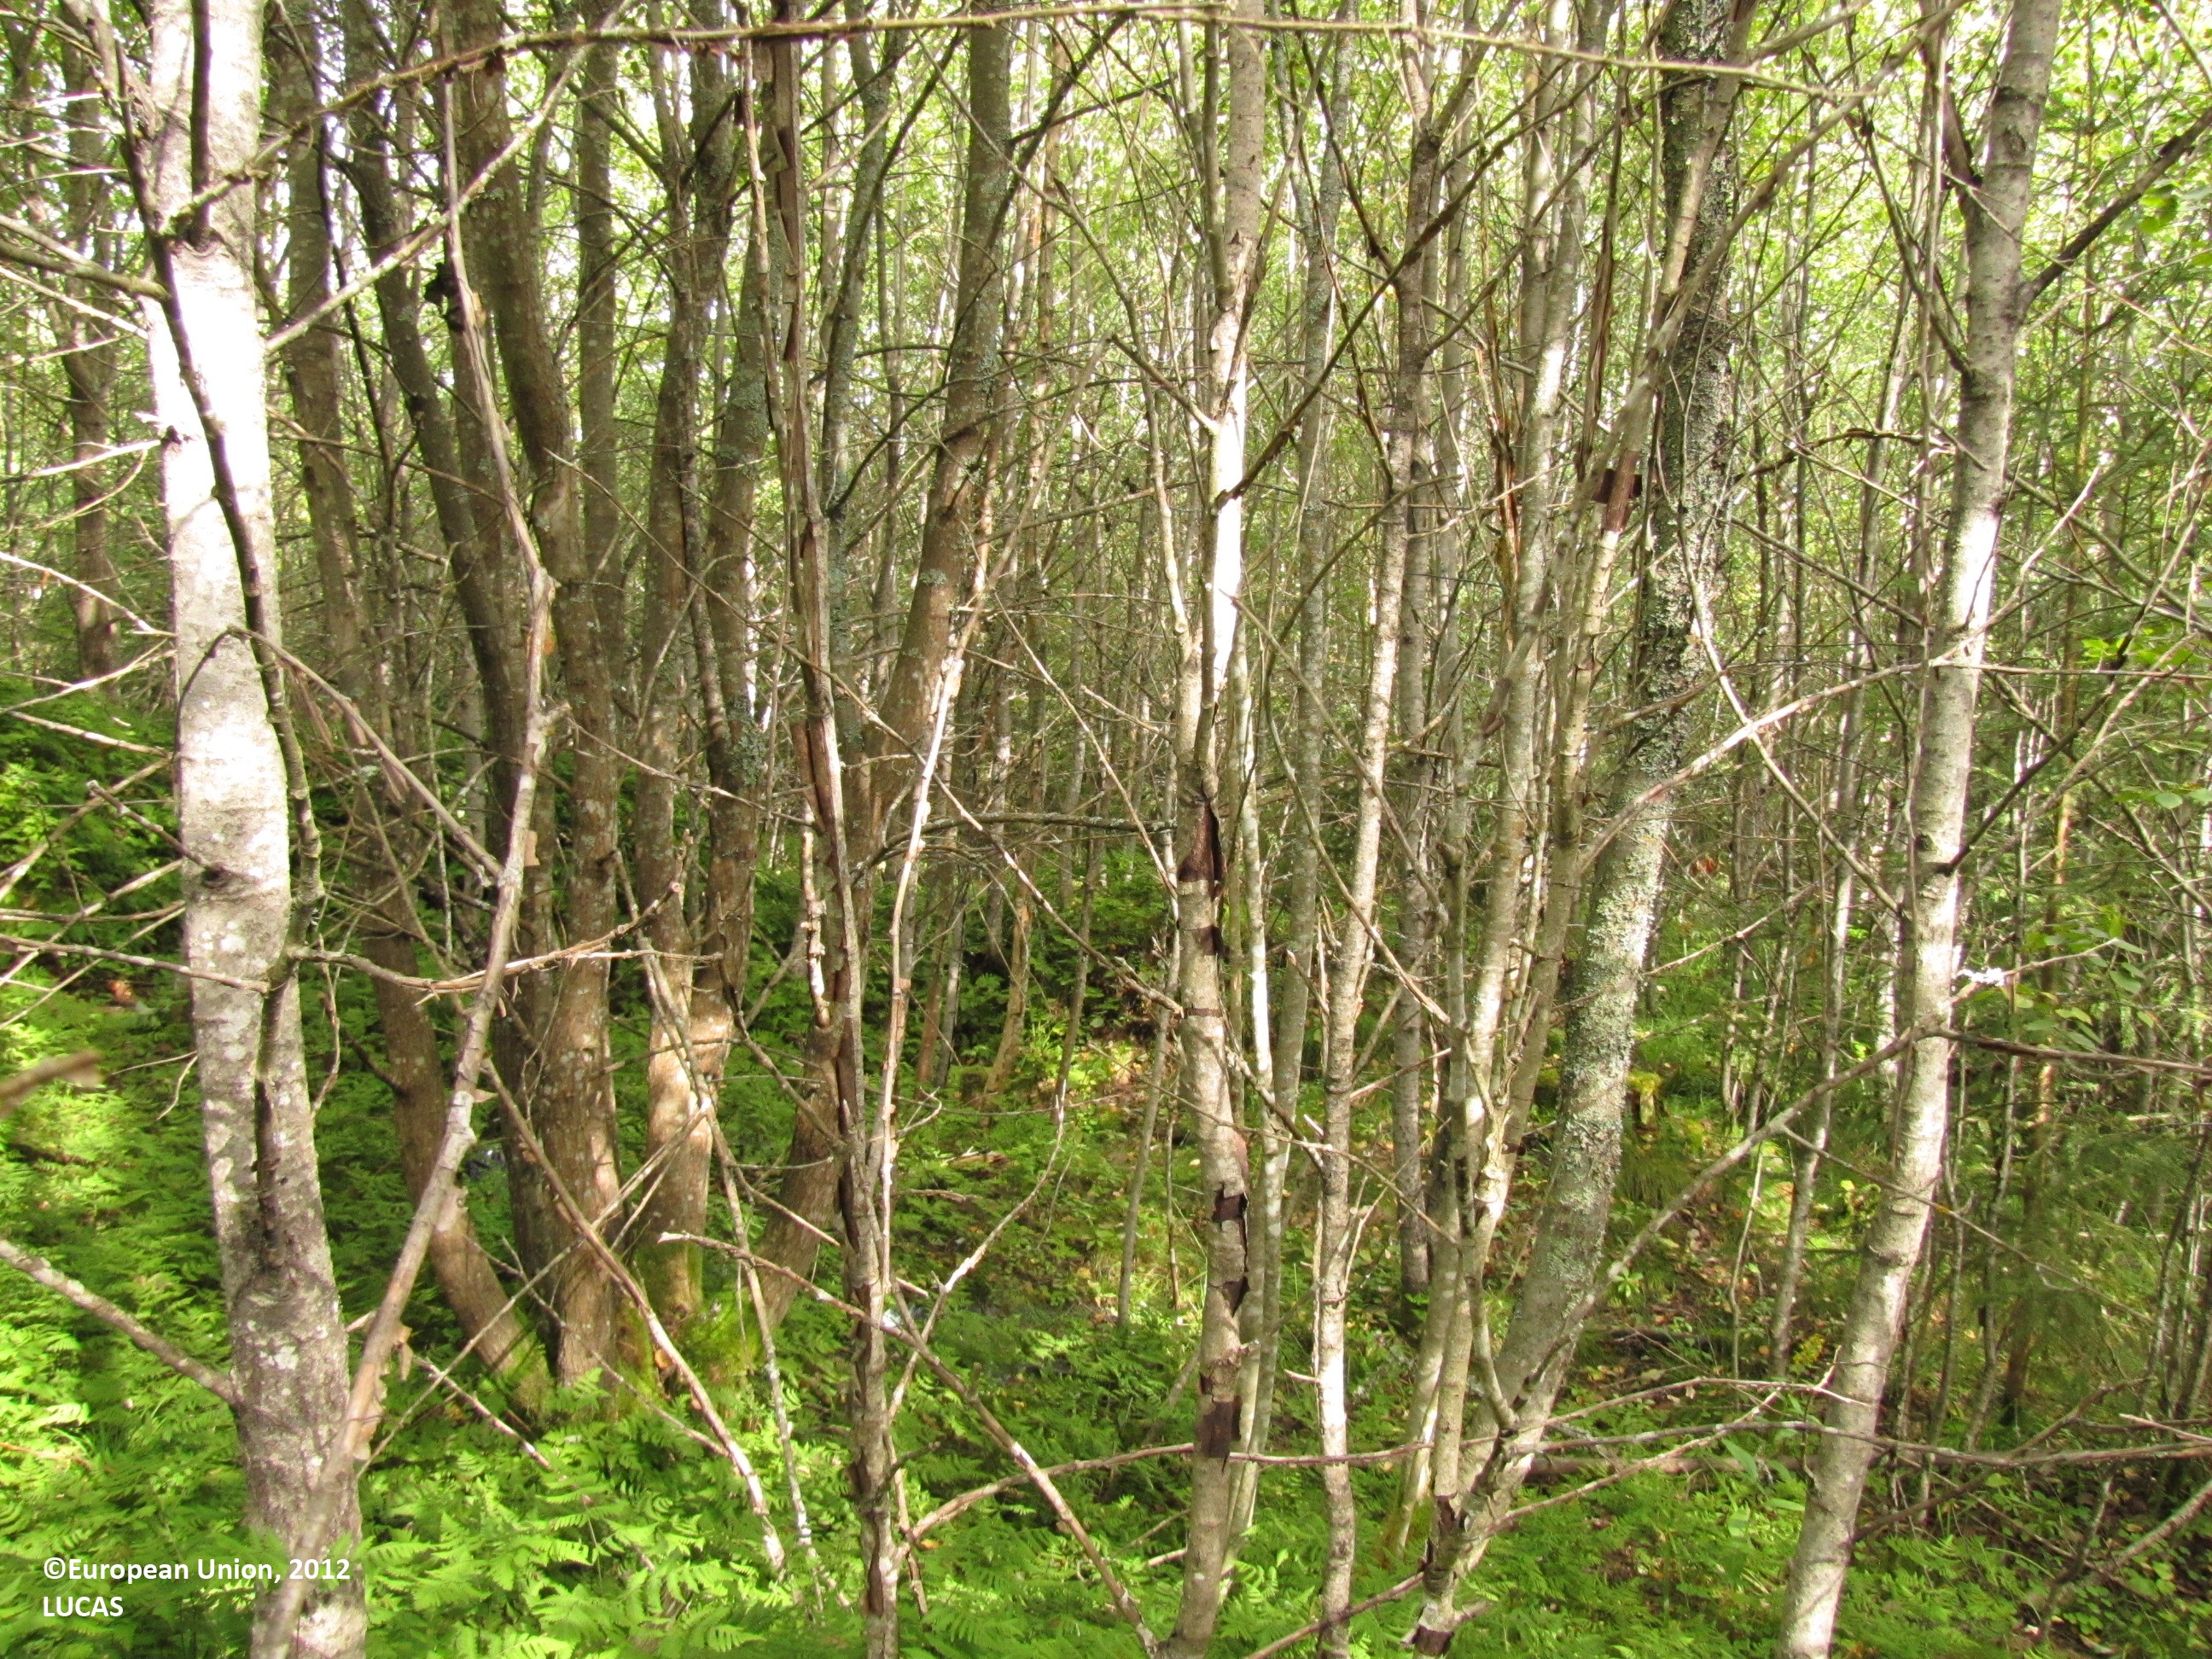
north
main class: Woodland
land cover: Broadleaved woodland
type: boreal forest
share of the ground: > 75 %
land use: Forestry
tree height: > 5 m
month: August
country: FI
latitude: 61.8858
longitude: 22.9455
